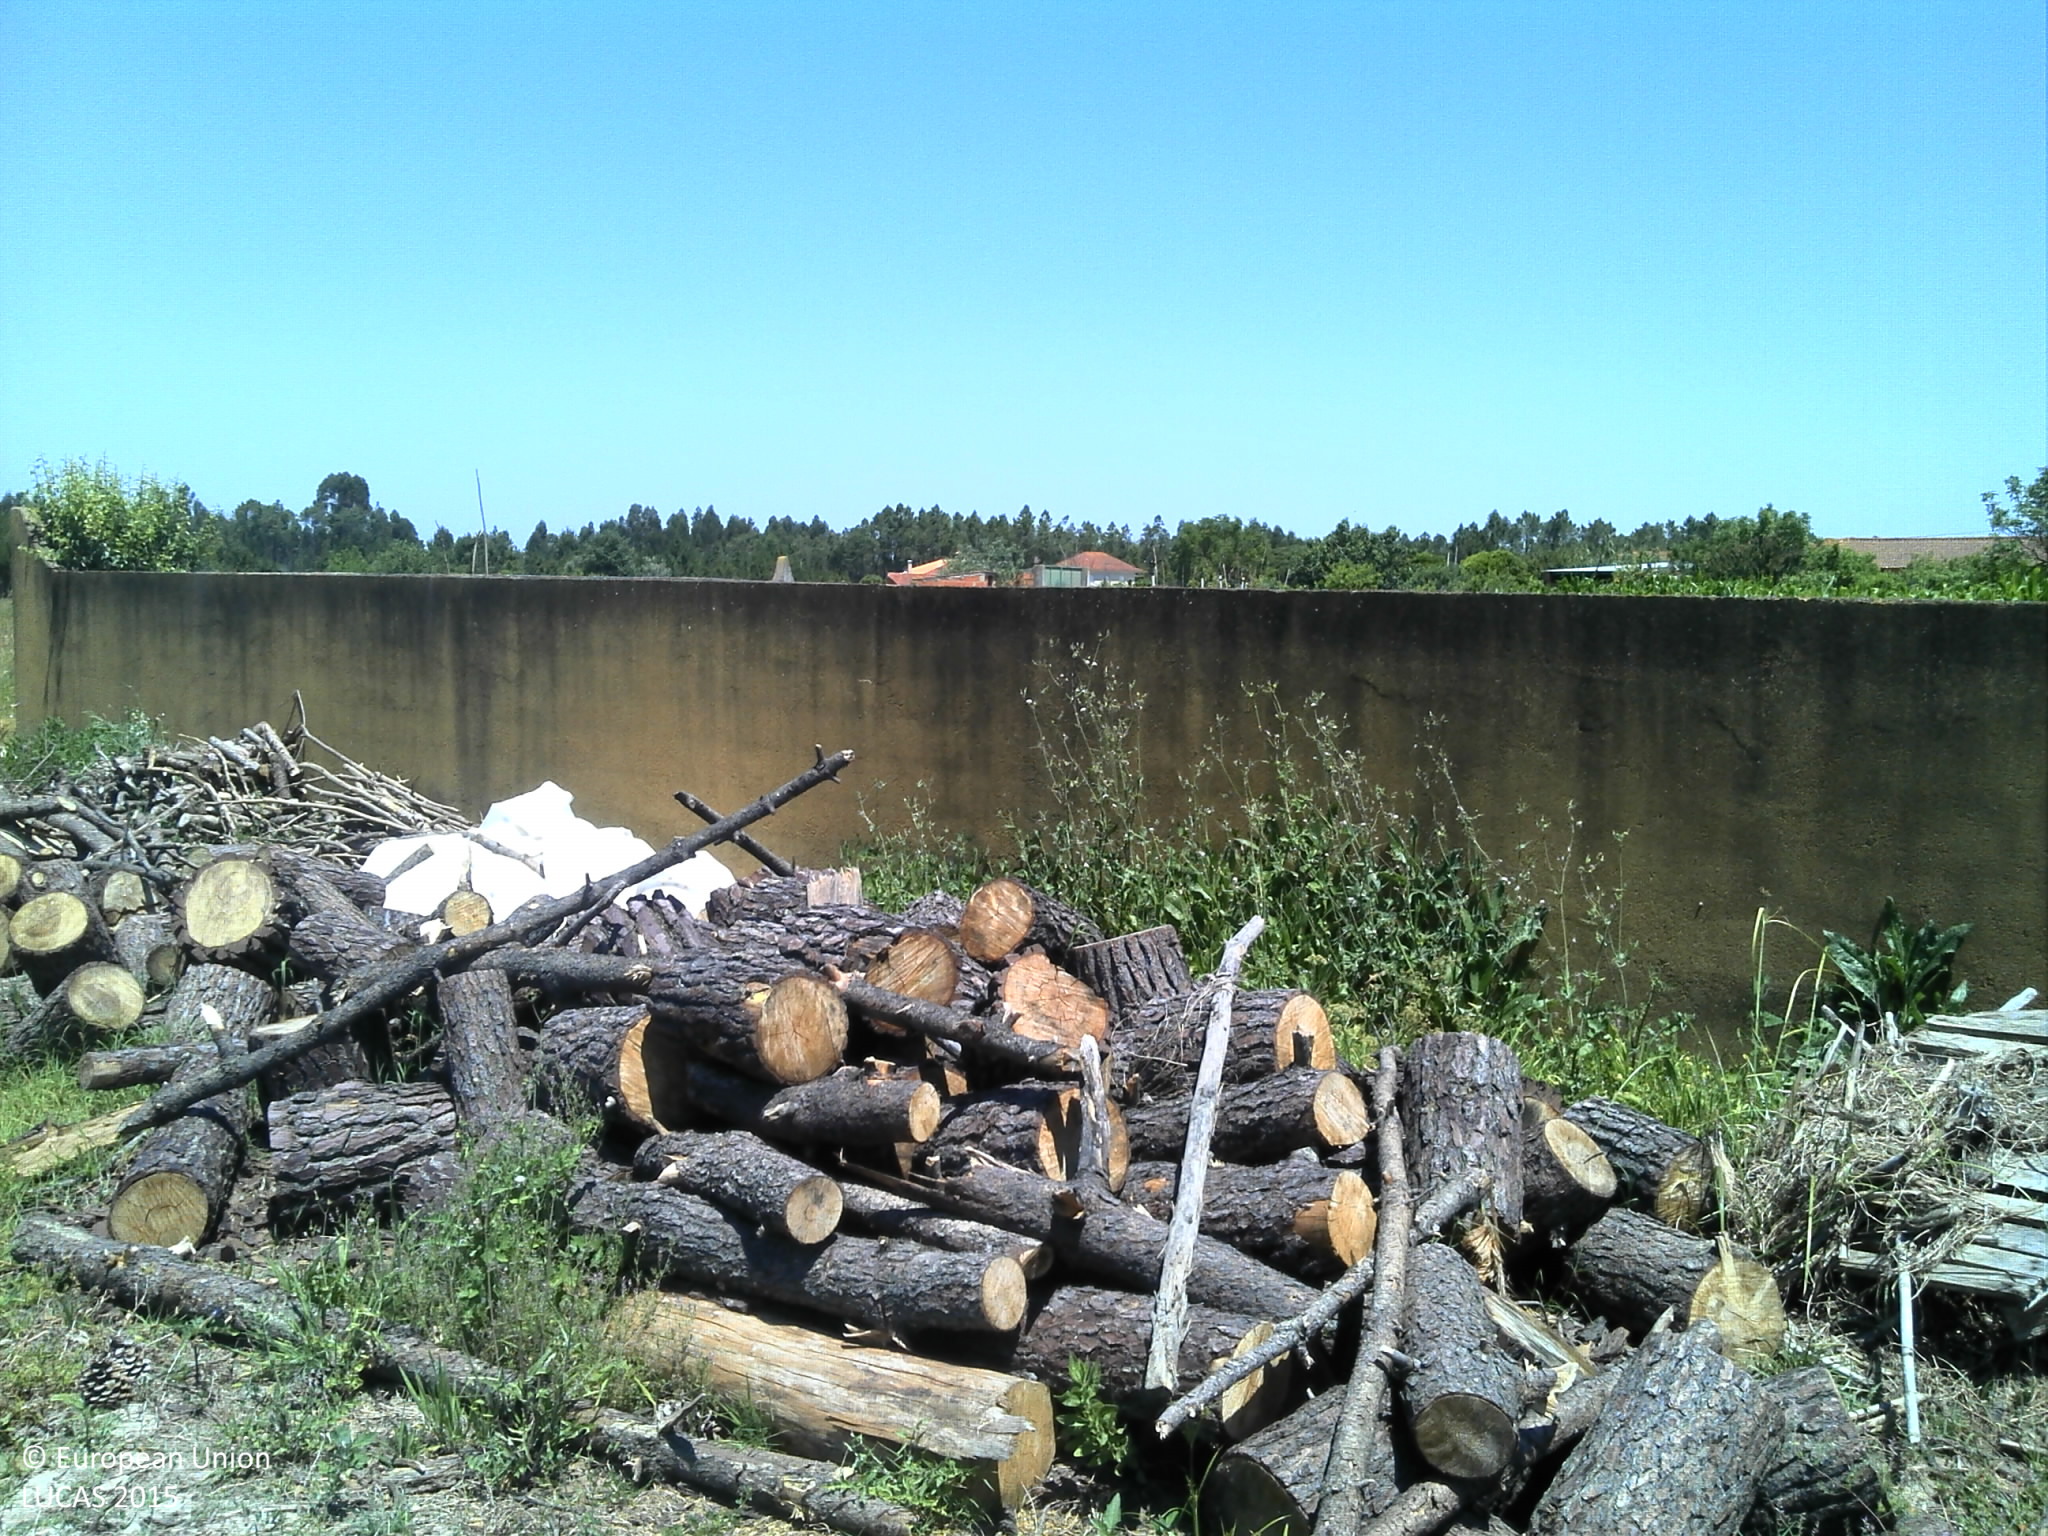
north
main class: Cropland
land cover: Maize
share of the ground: 10 - 25 %
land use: Agriculture (excluding fallow land and kitchen gardens)
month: May
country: PT
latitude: 40.4651
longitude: -8.6214
